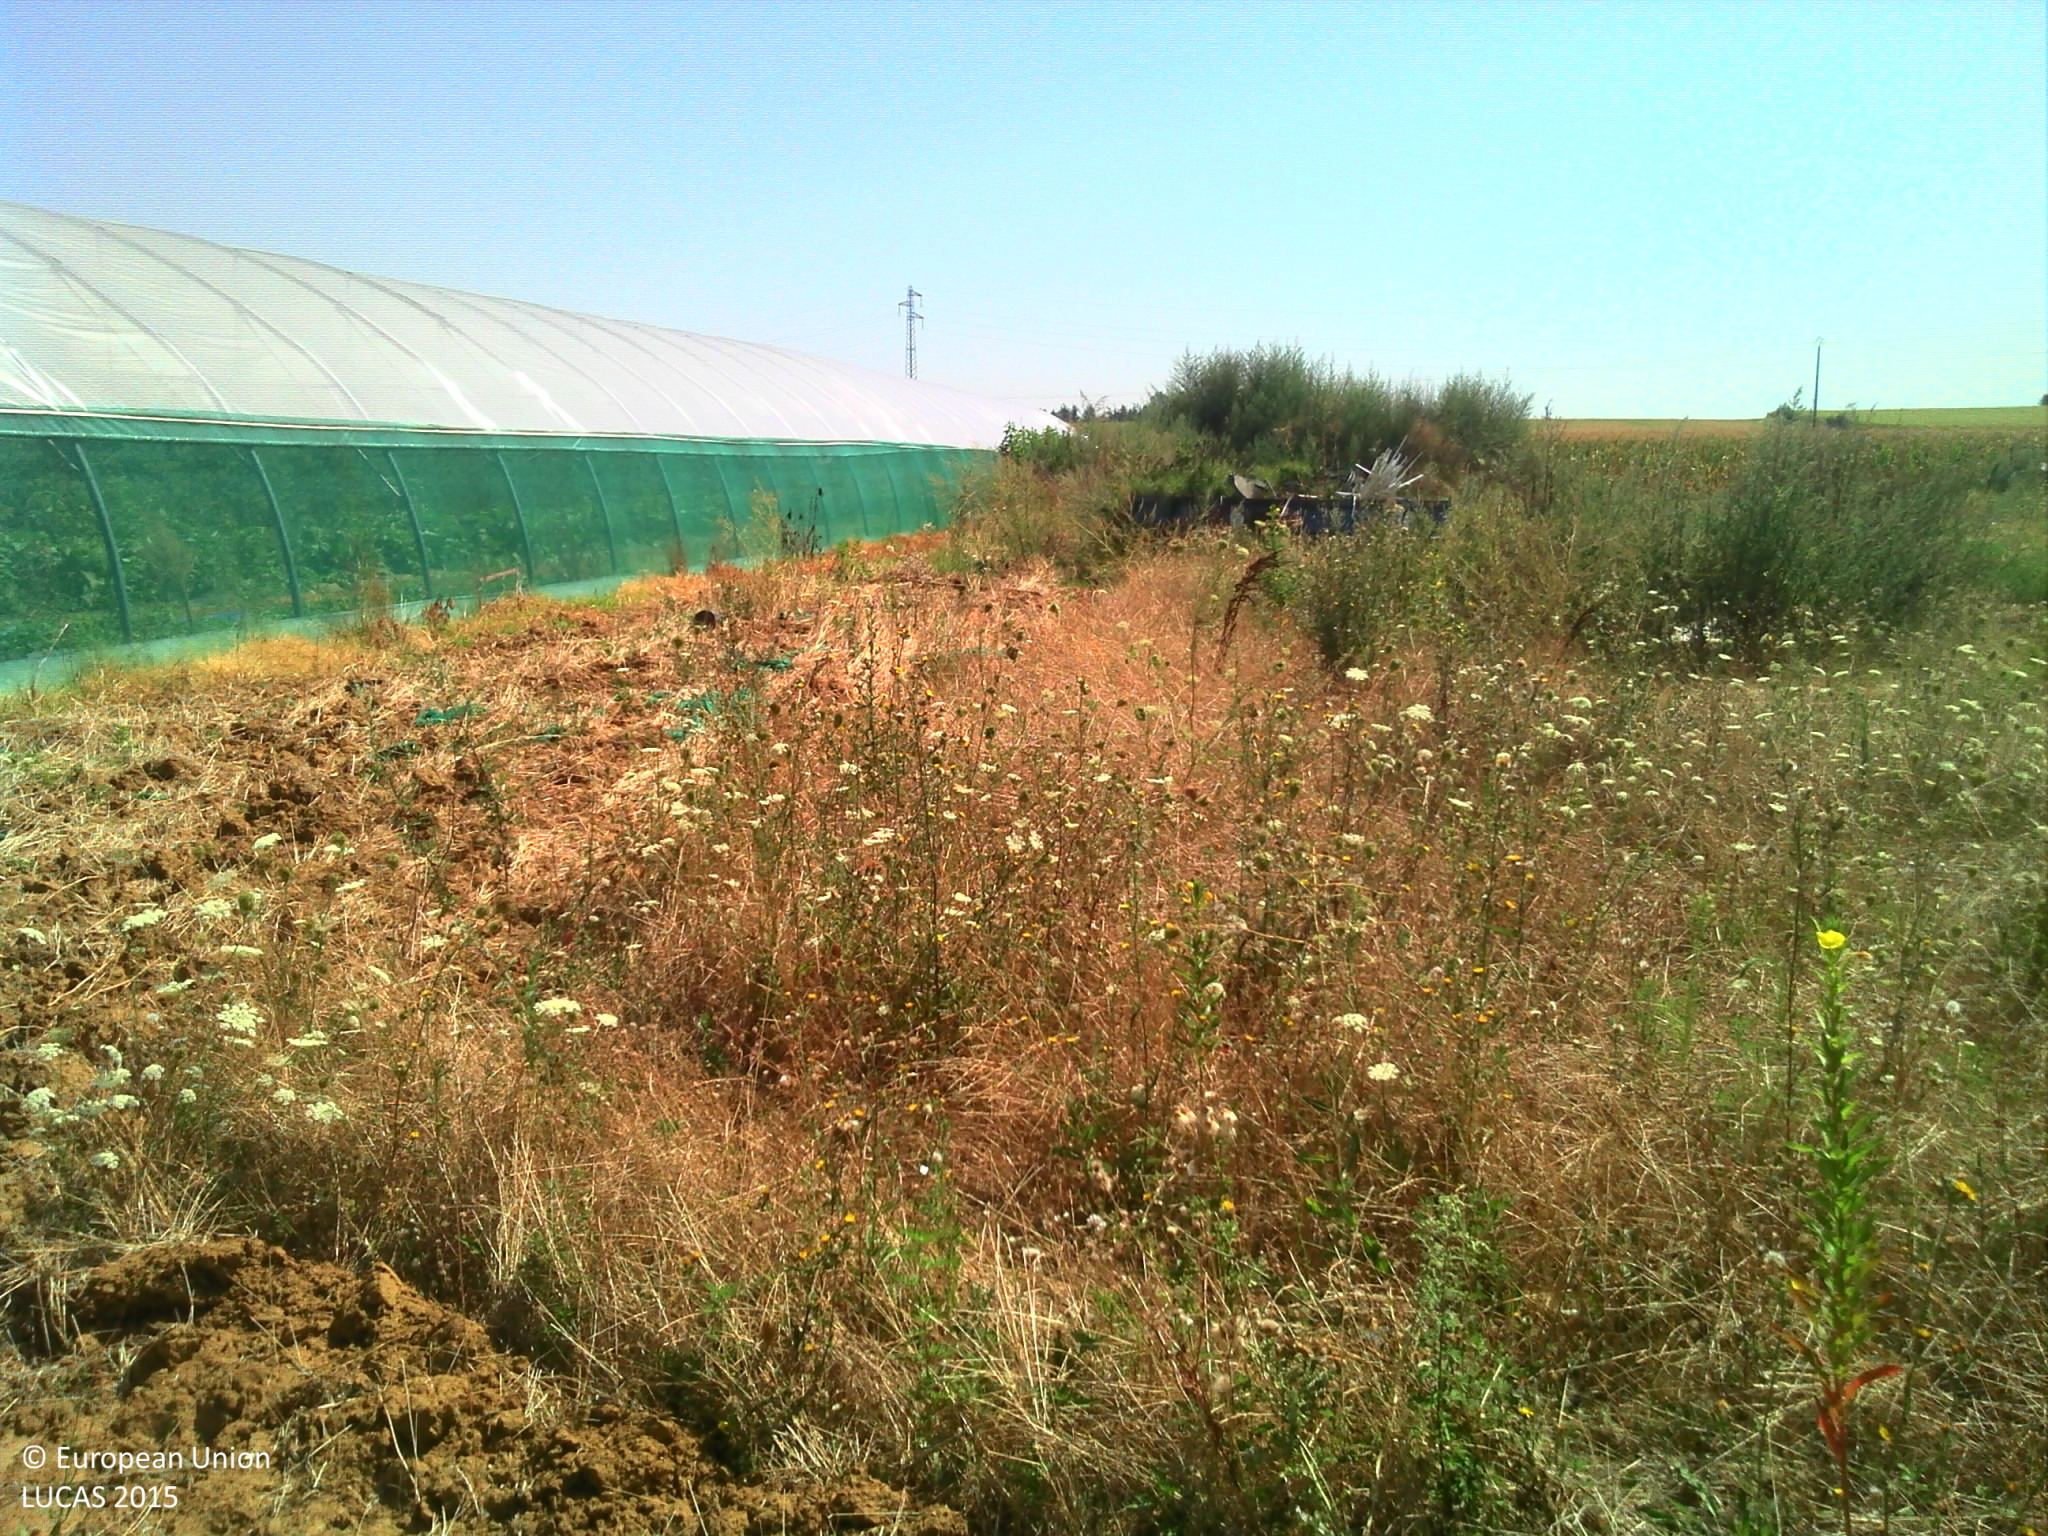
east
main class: Grassland
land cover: Spontaneously vegetated surfaces
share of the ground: > 75 %
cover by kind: herbaceous plants 95 %, shrubs 5 %
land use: Agriculture (excluding fallow land and kitchen gardens)
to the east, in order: Spontaneously vegetated surfaces; Other bare soil; Spontaneously vegetated surfaces; Maize; Common wheat; Tracks; Other root crops; Common wheat
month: August
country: FR
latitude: 45.6500
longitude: 4.8583
